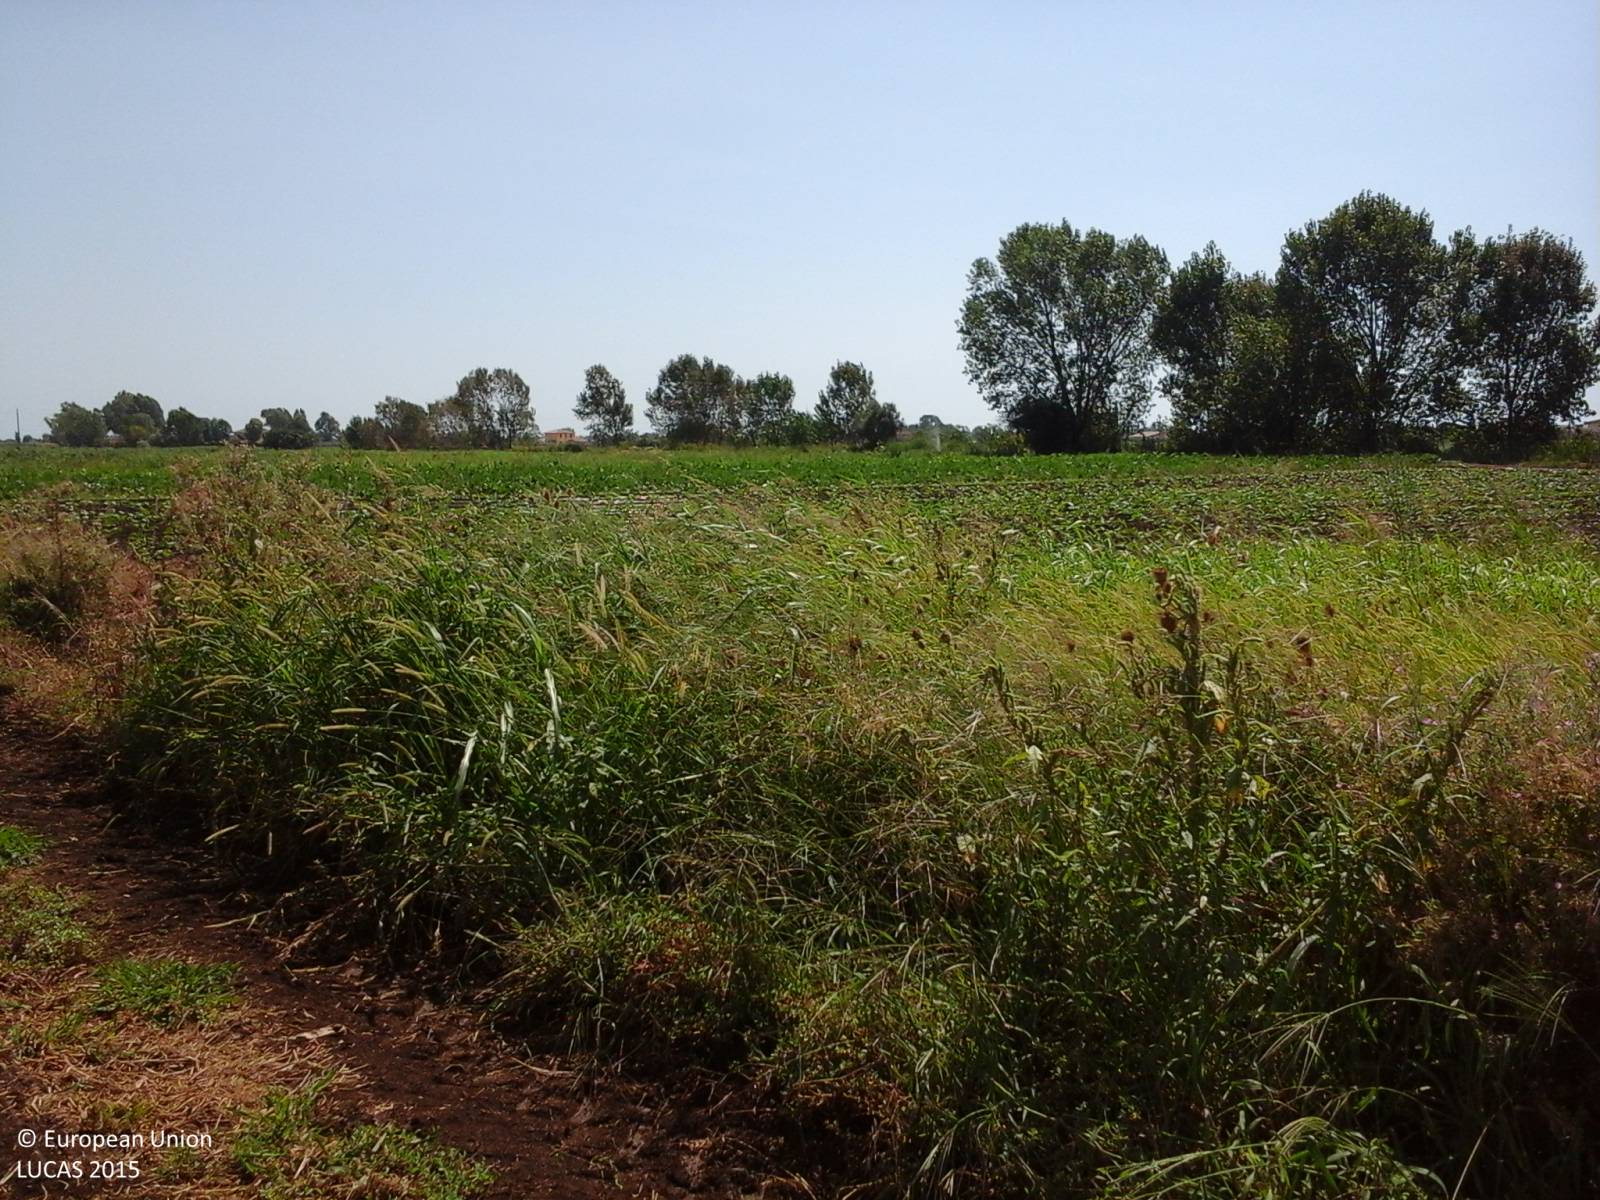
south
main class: Cropland
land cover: Other fresh vegetables
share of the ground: < 10 %
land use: Agriculture (excluding fallow land and kitchen gardens)
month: August
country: IT
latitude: 41.4888
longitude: 12.9945
